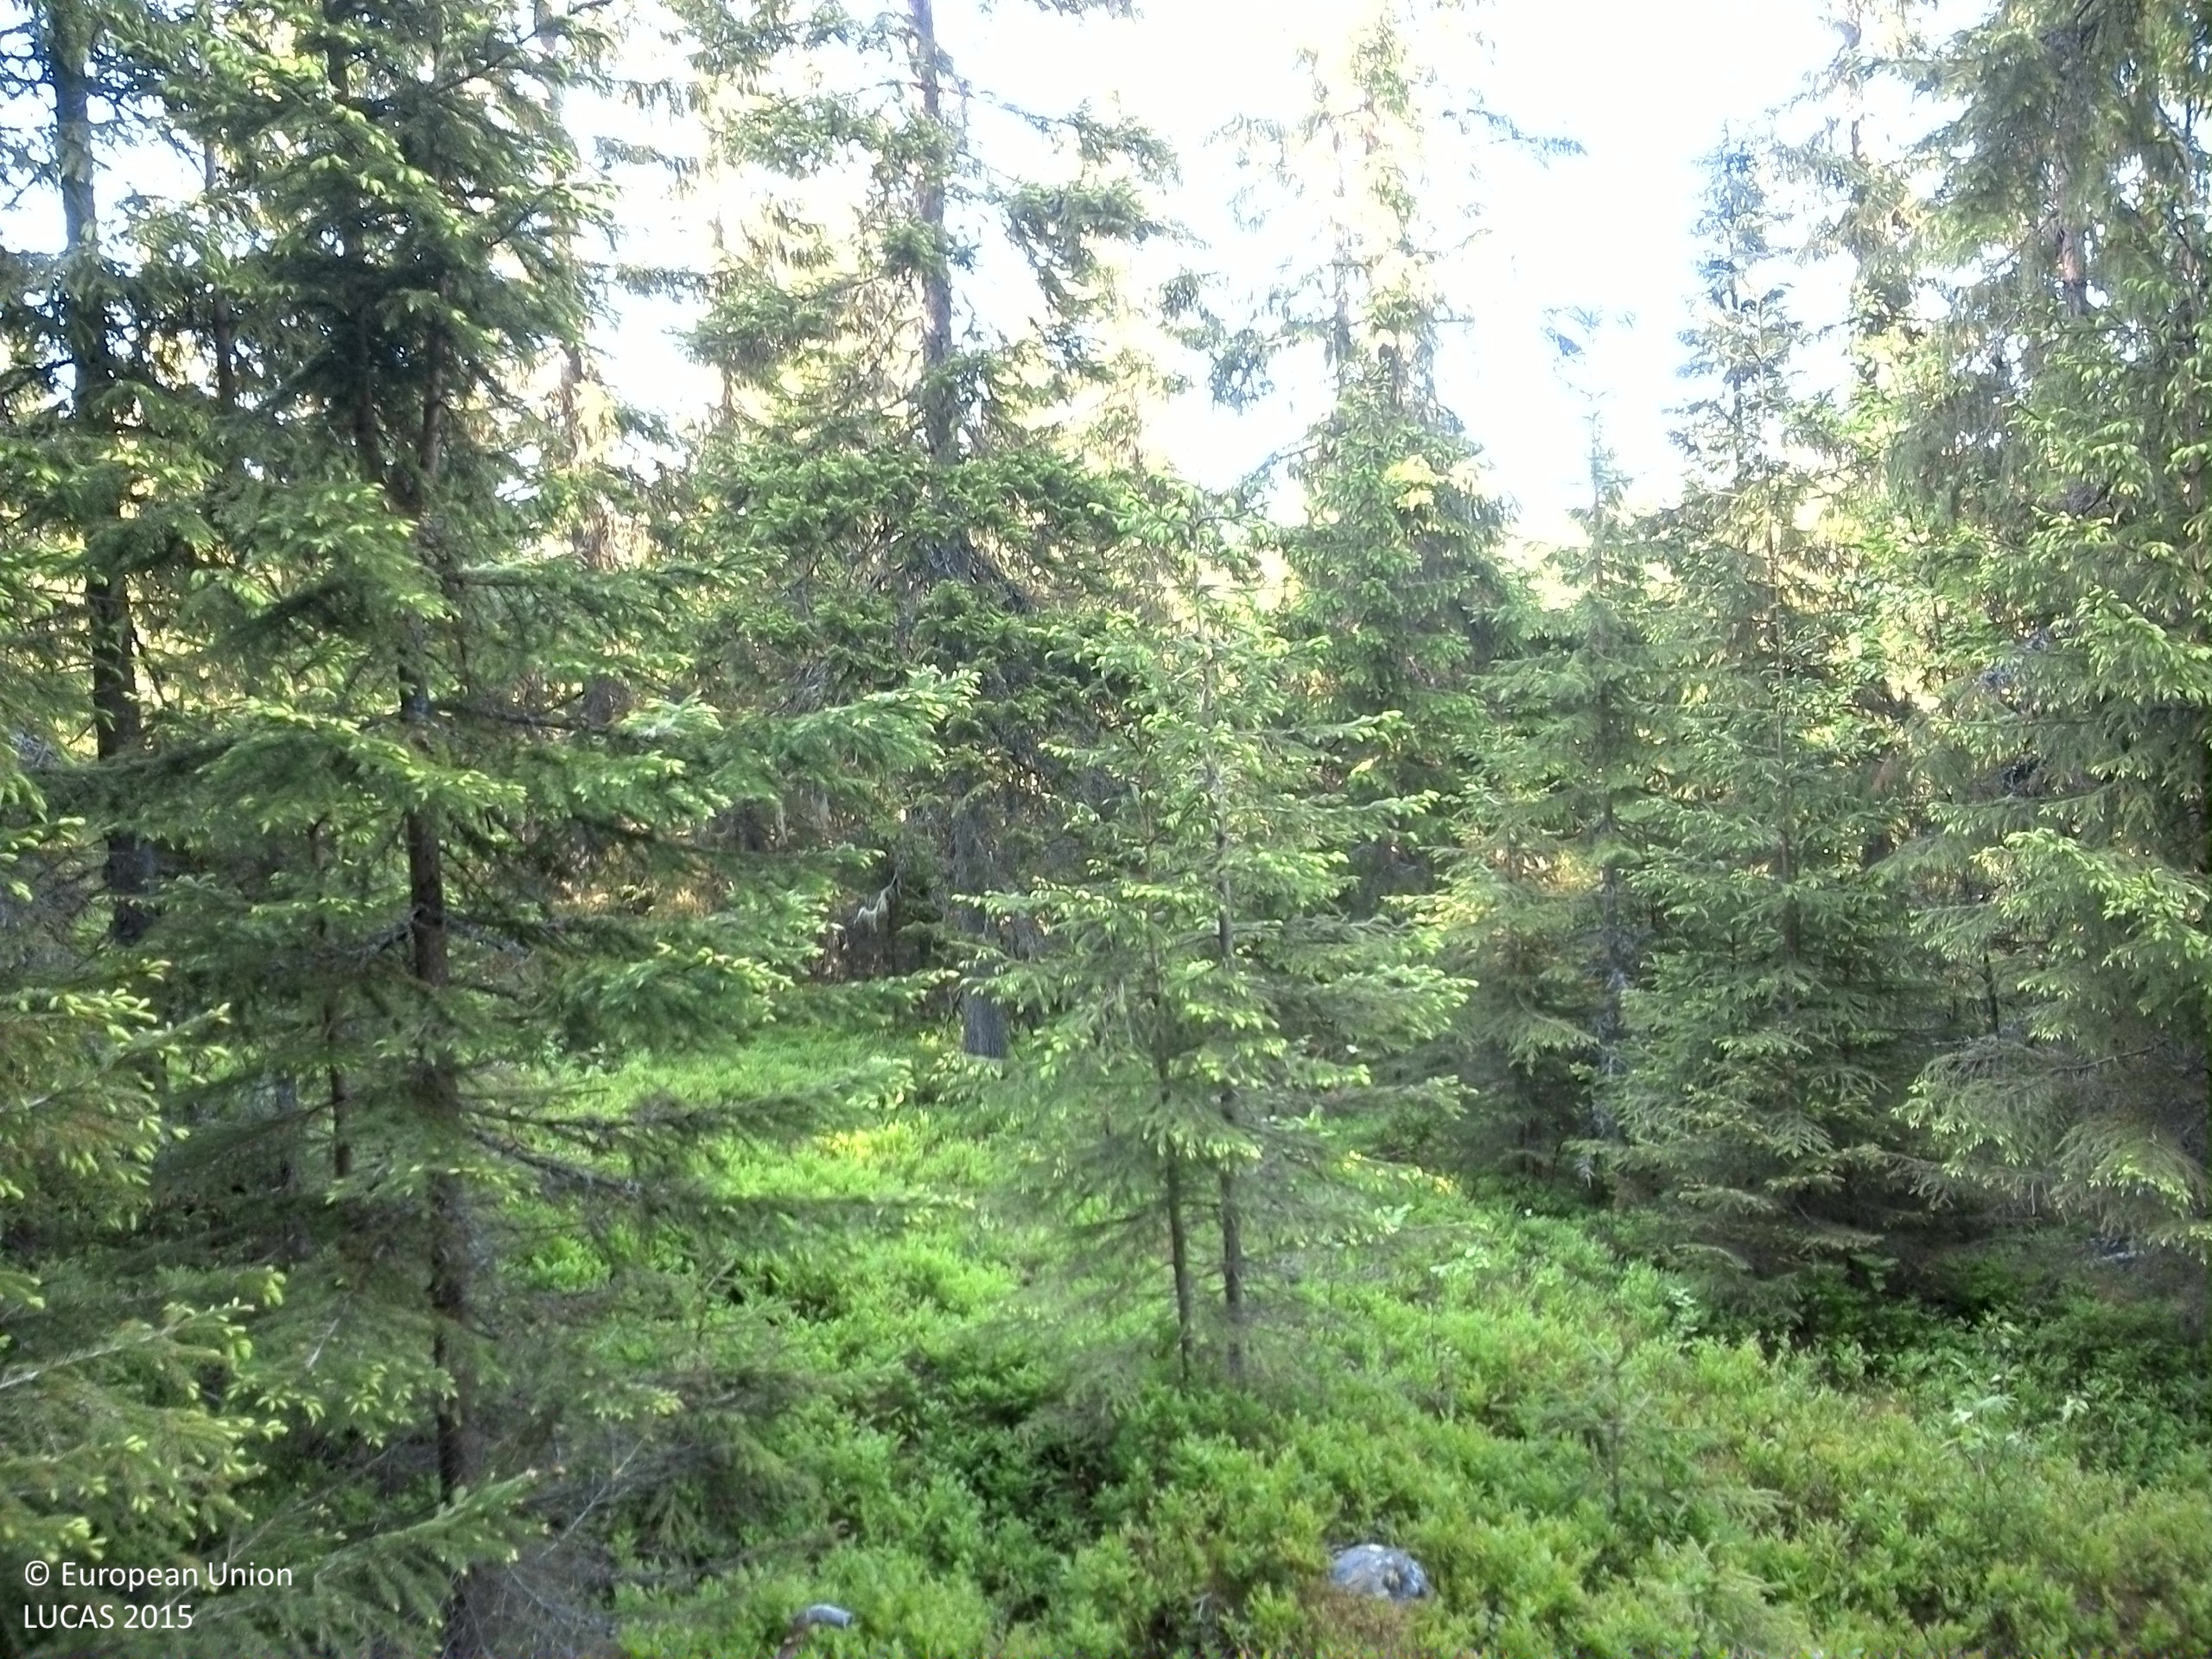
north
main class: Woodland
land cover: Spruce dominated coniferous woodland
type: boreal forest
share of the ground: 50 - 75 %
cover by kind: coniferous forest trees 60 %, shrubs 35 %, broadleaved forest trees 5 %
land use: Forestry
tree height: > 5 m
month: June
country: SE
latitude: 62.7570
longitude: 17.7528
